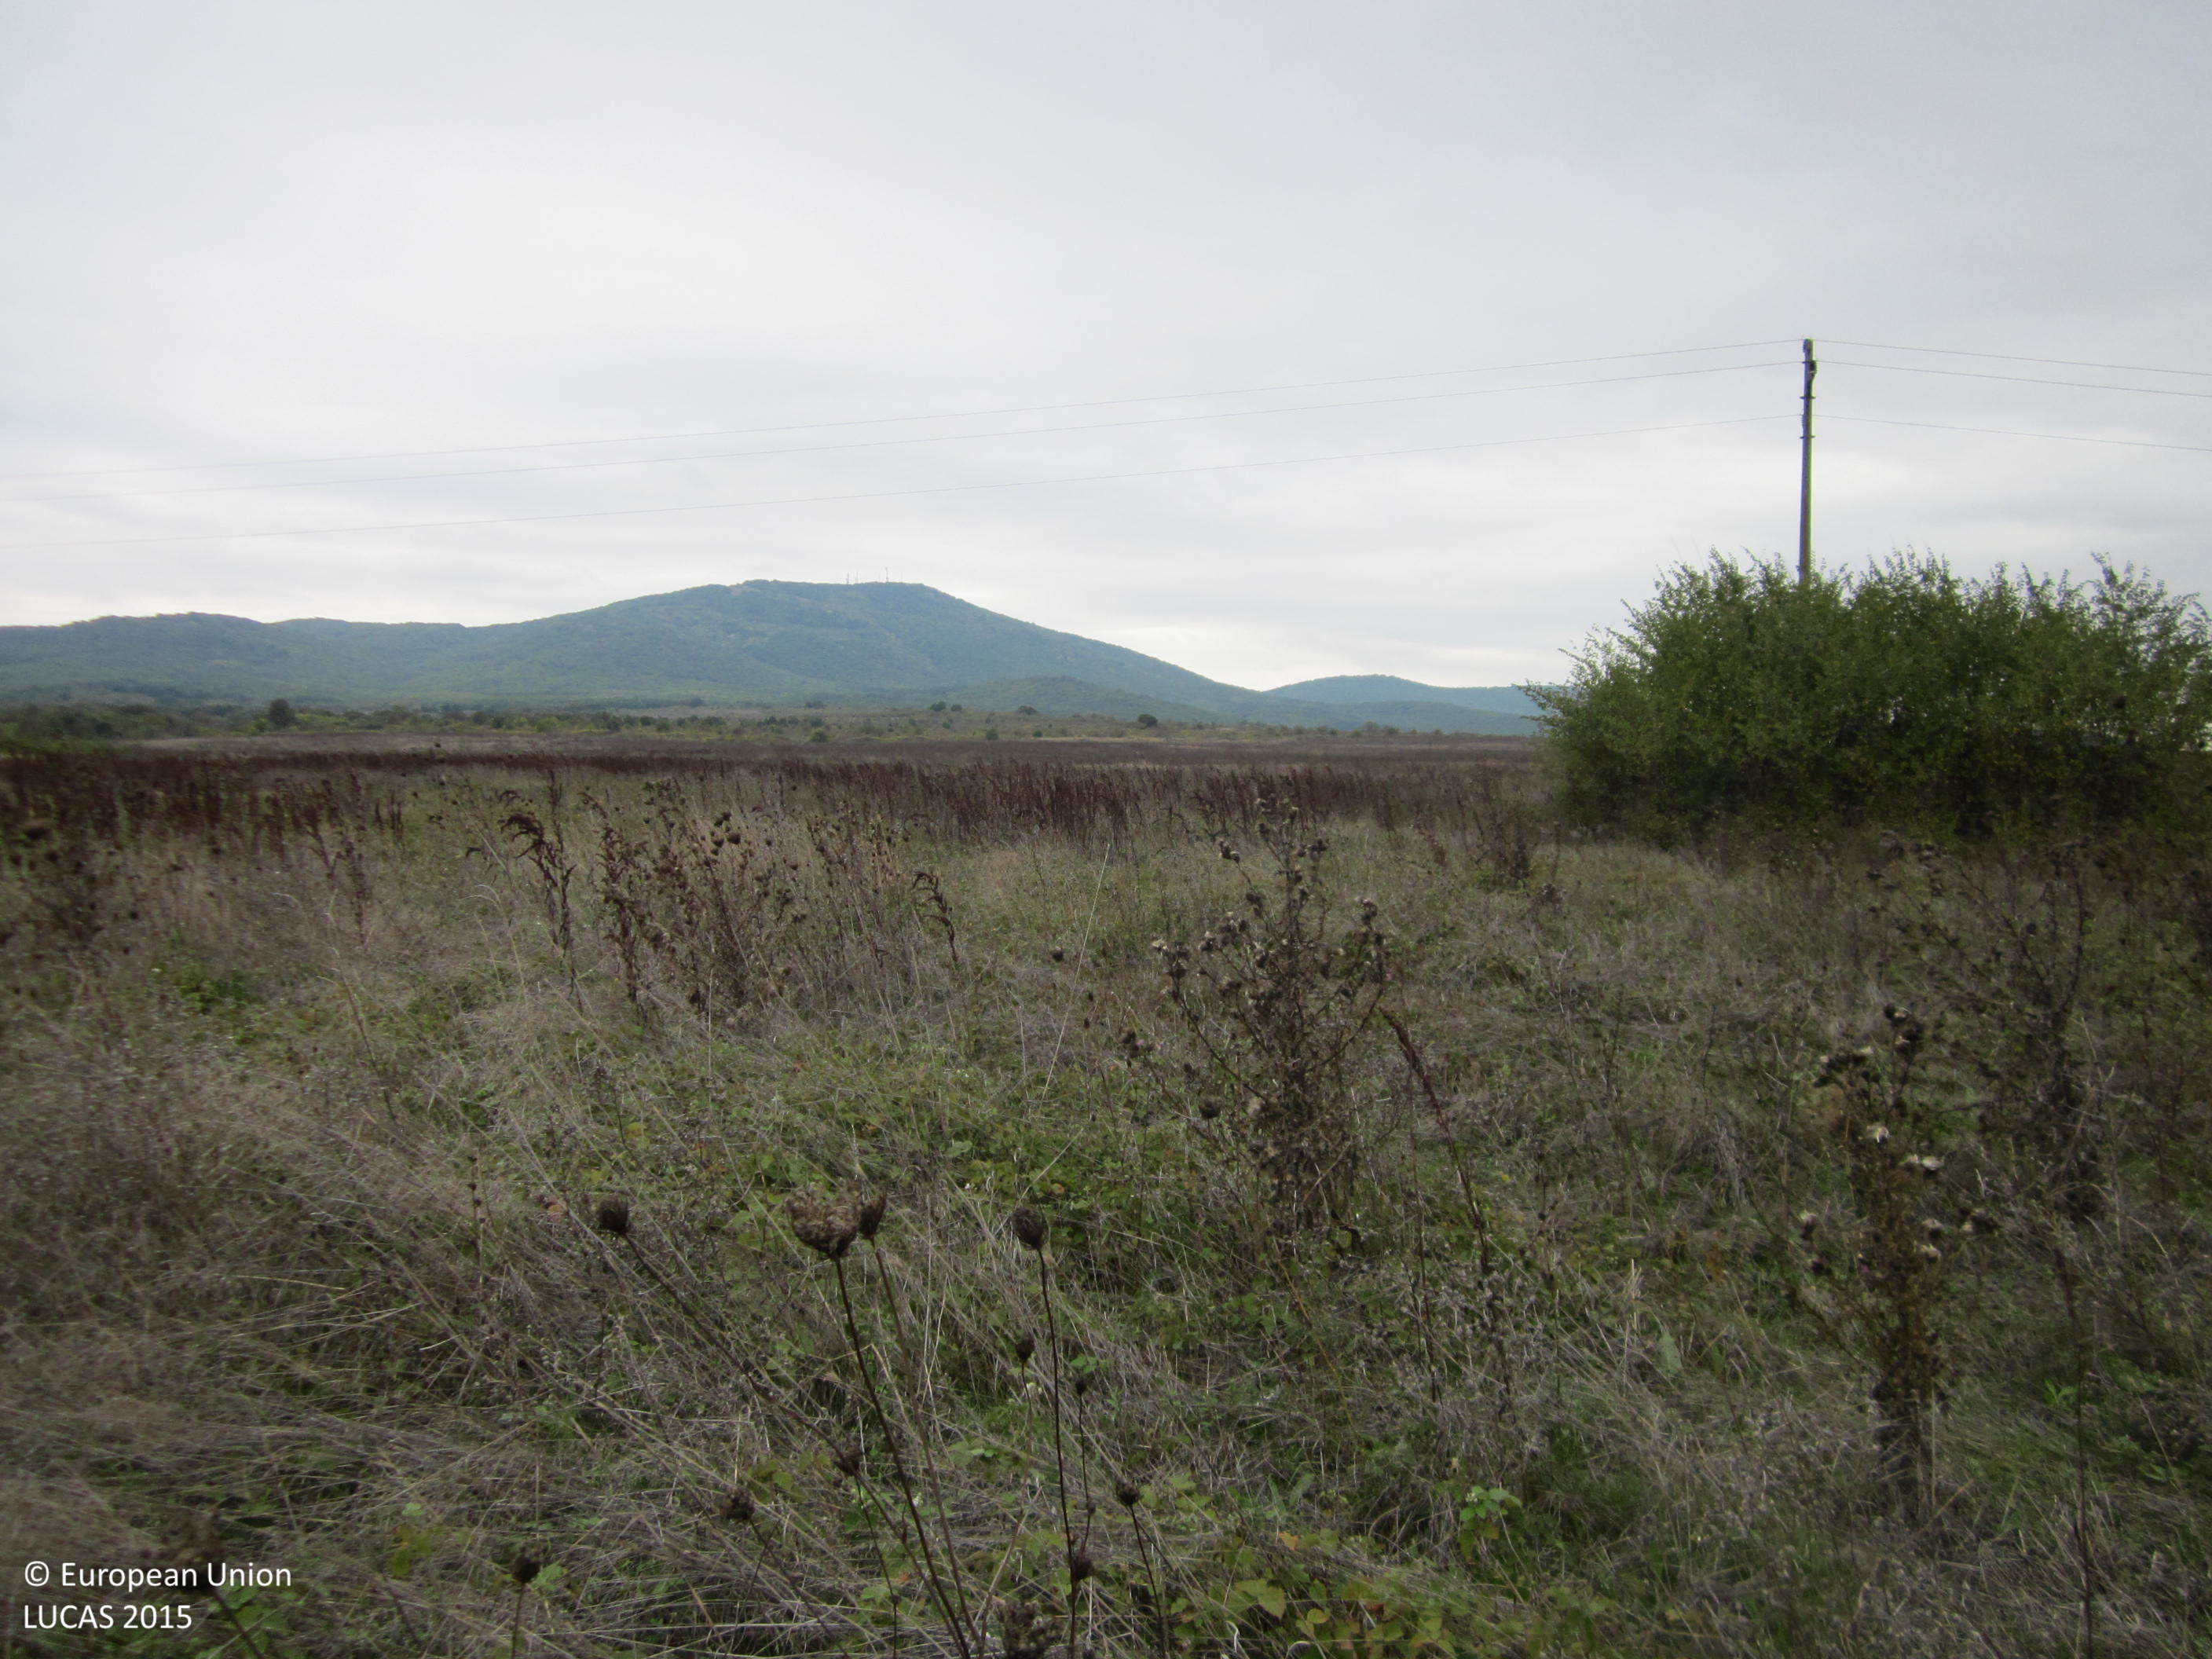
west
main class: Grassland
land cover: Spontaneously vegetated surfaces
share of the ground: > 75 %
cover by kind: herbaceous plants 100 %
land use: Fallow land
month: October
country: BG
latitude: 42.3986
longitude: 27.6514
